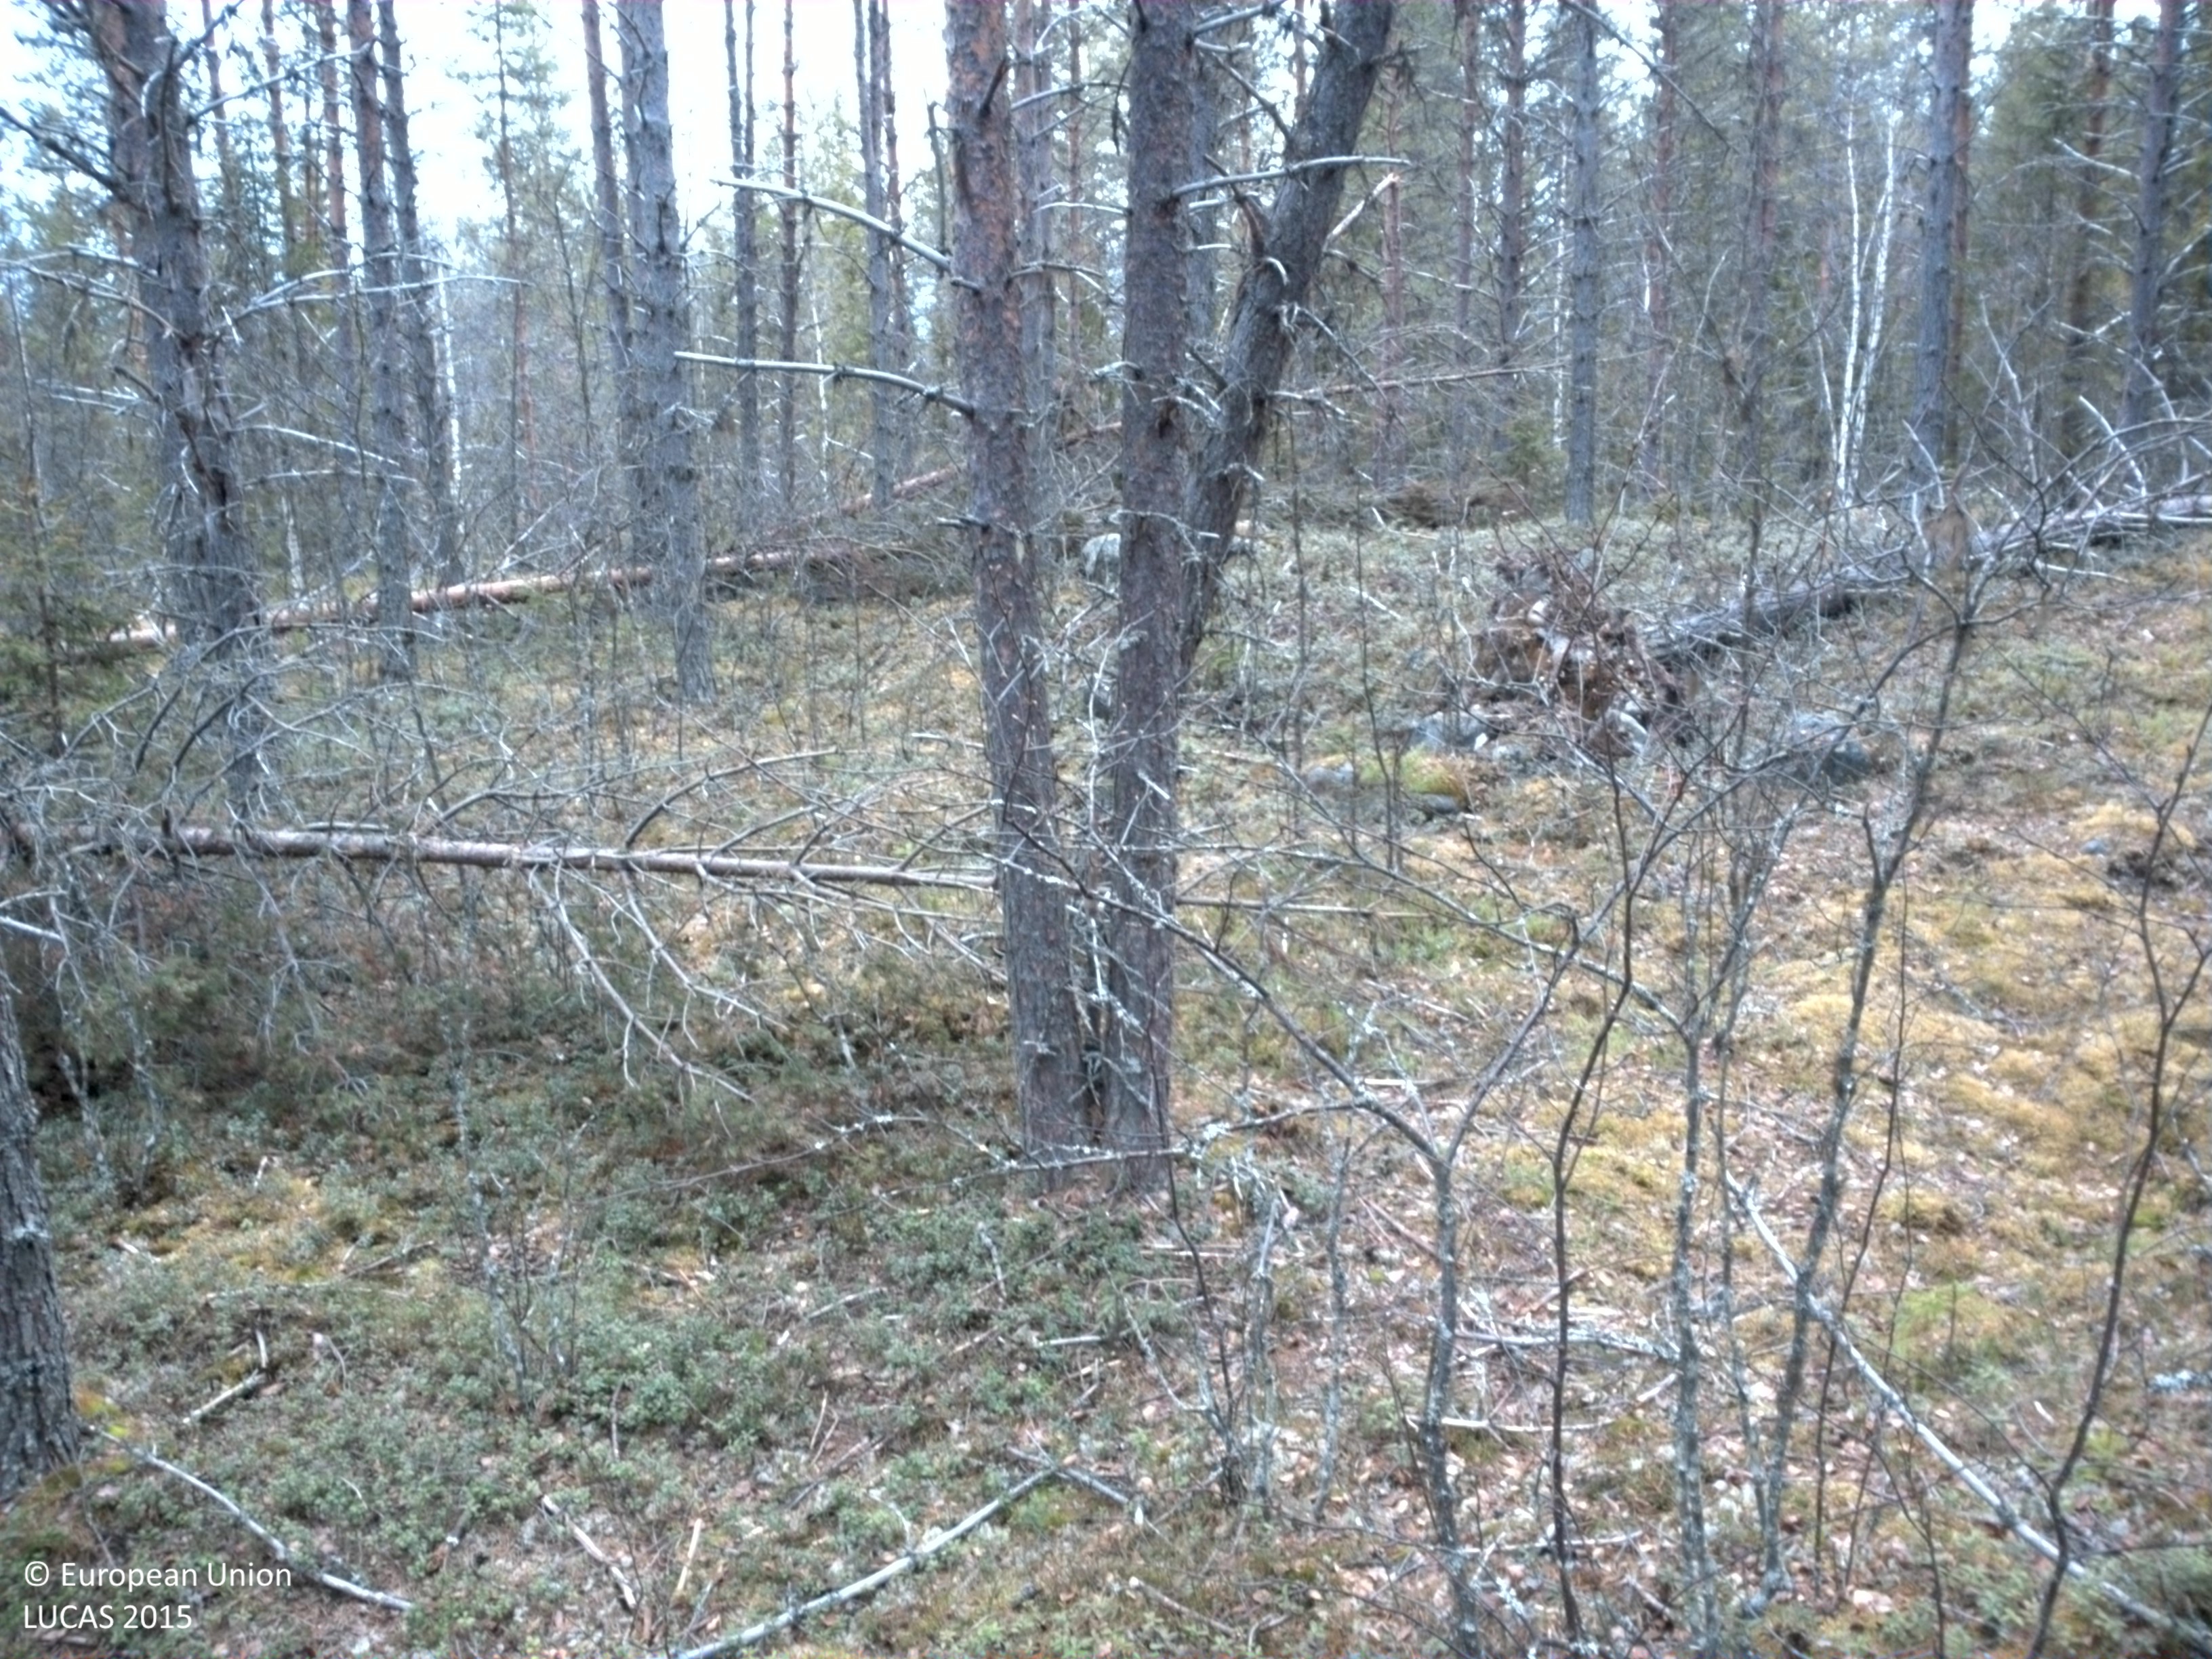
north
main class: Woodland
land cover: Pine dominated coniferous woodland
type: boreal forest
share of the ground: 25 - 50 %
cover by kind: coniferous forest trees 40 %, lichens and mosses 30 %, herbaceous plants 20 %, broadleaved forest trees 10 %
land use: Forestry
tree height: > 5 m
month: May
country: SE
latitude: 64.2943
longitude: 18.2141
